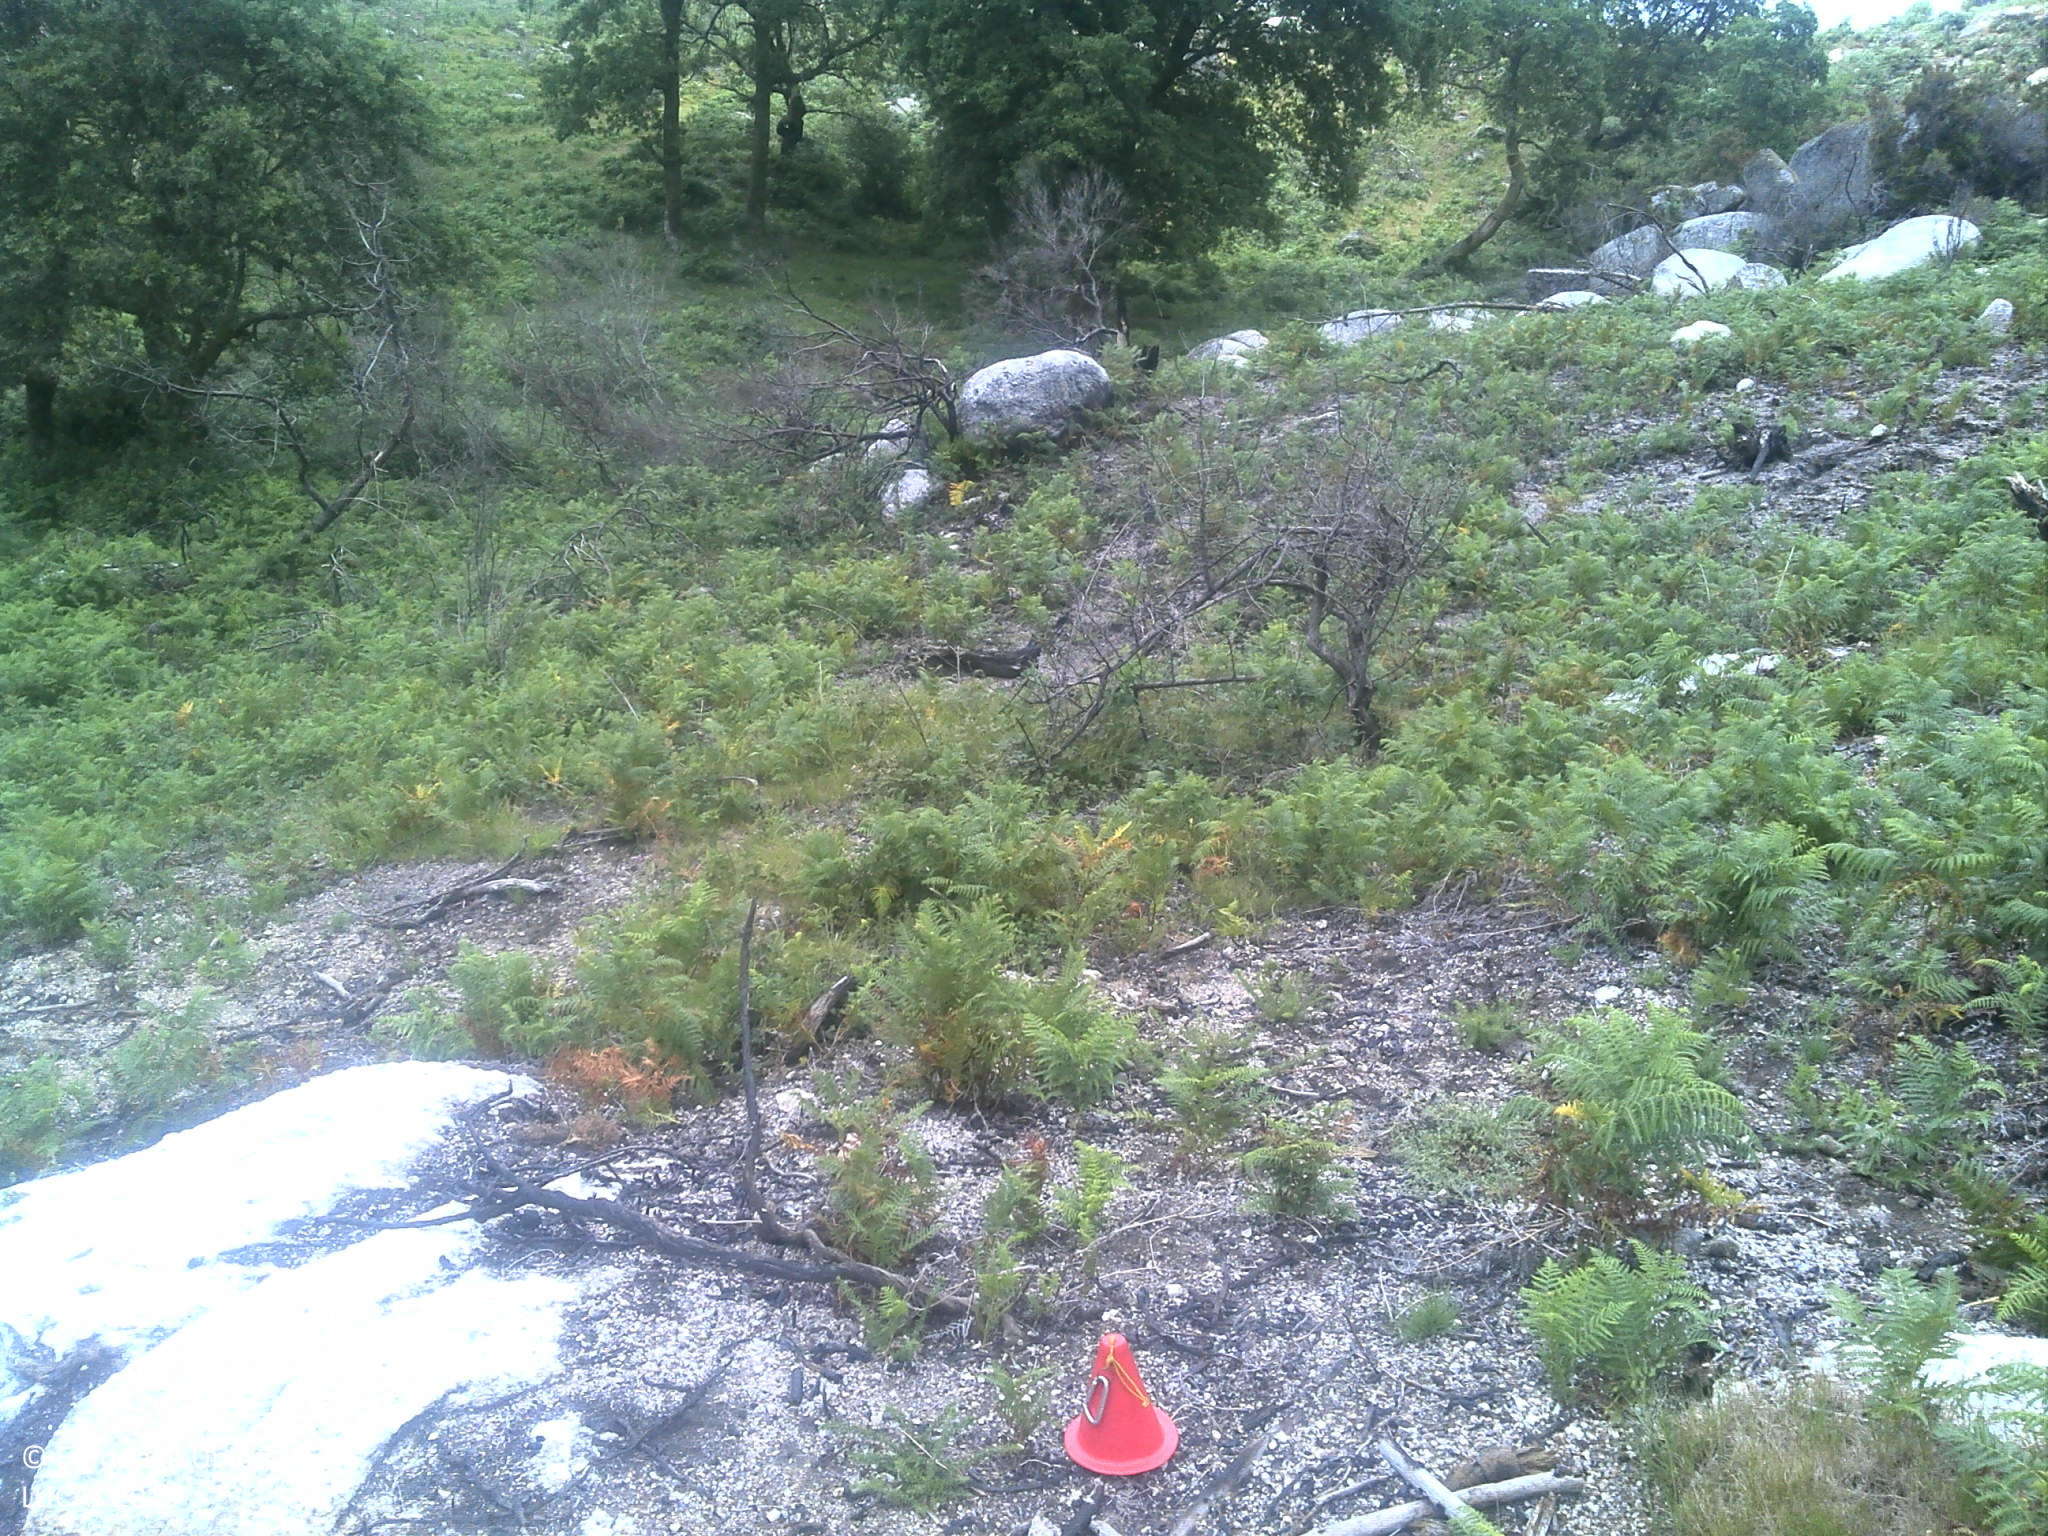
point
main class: Shrubland
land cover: Shrubland without tree cover
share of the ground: 50 - 75 %
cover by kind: shrubs 70 %, consolidated bare surface 20 %, unconsolidated bare surface 10 %
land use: Agriculture (excluding fallow land and kitchen gardens)
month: June
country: PT
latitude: 41.6846
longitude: -8.2309
